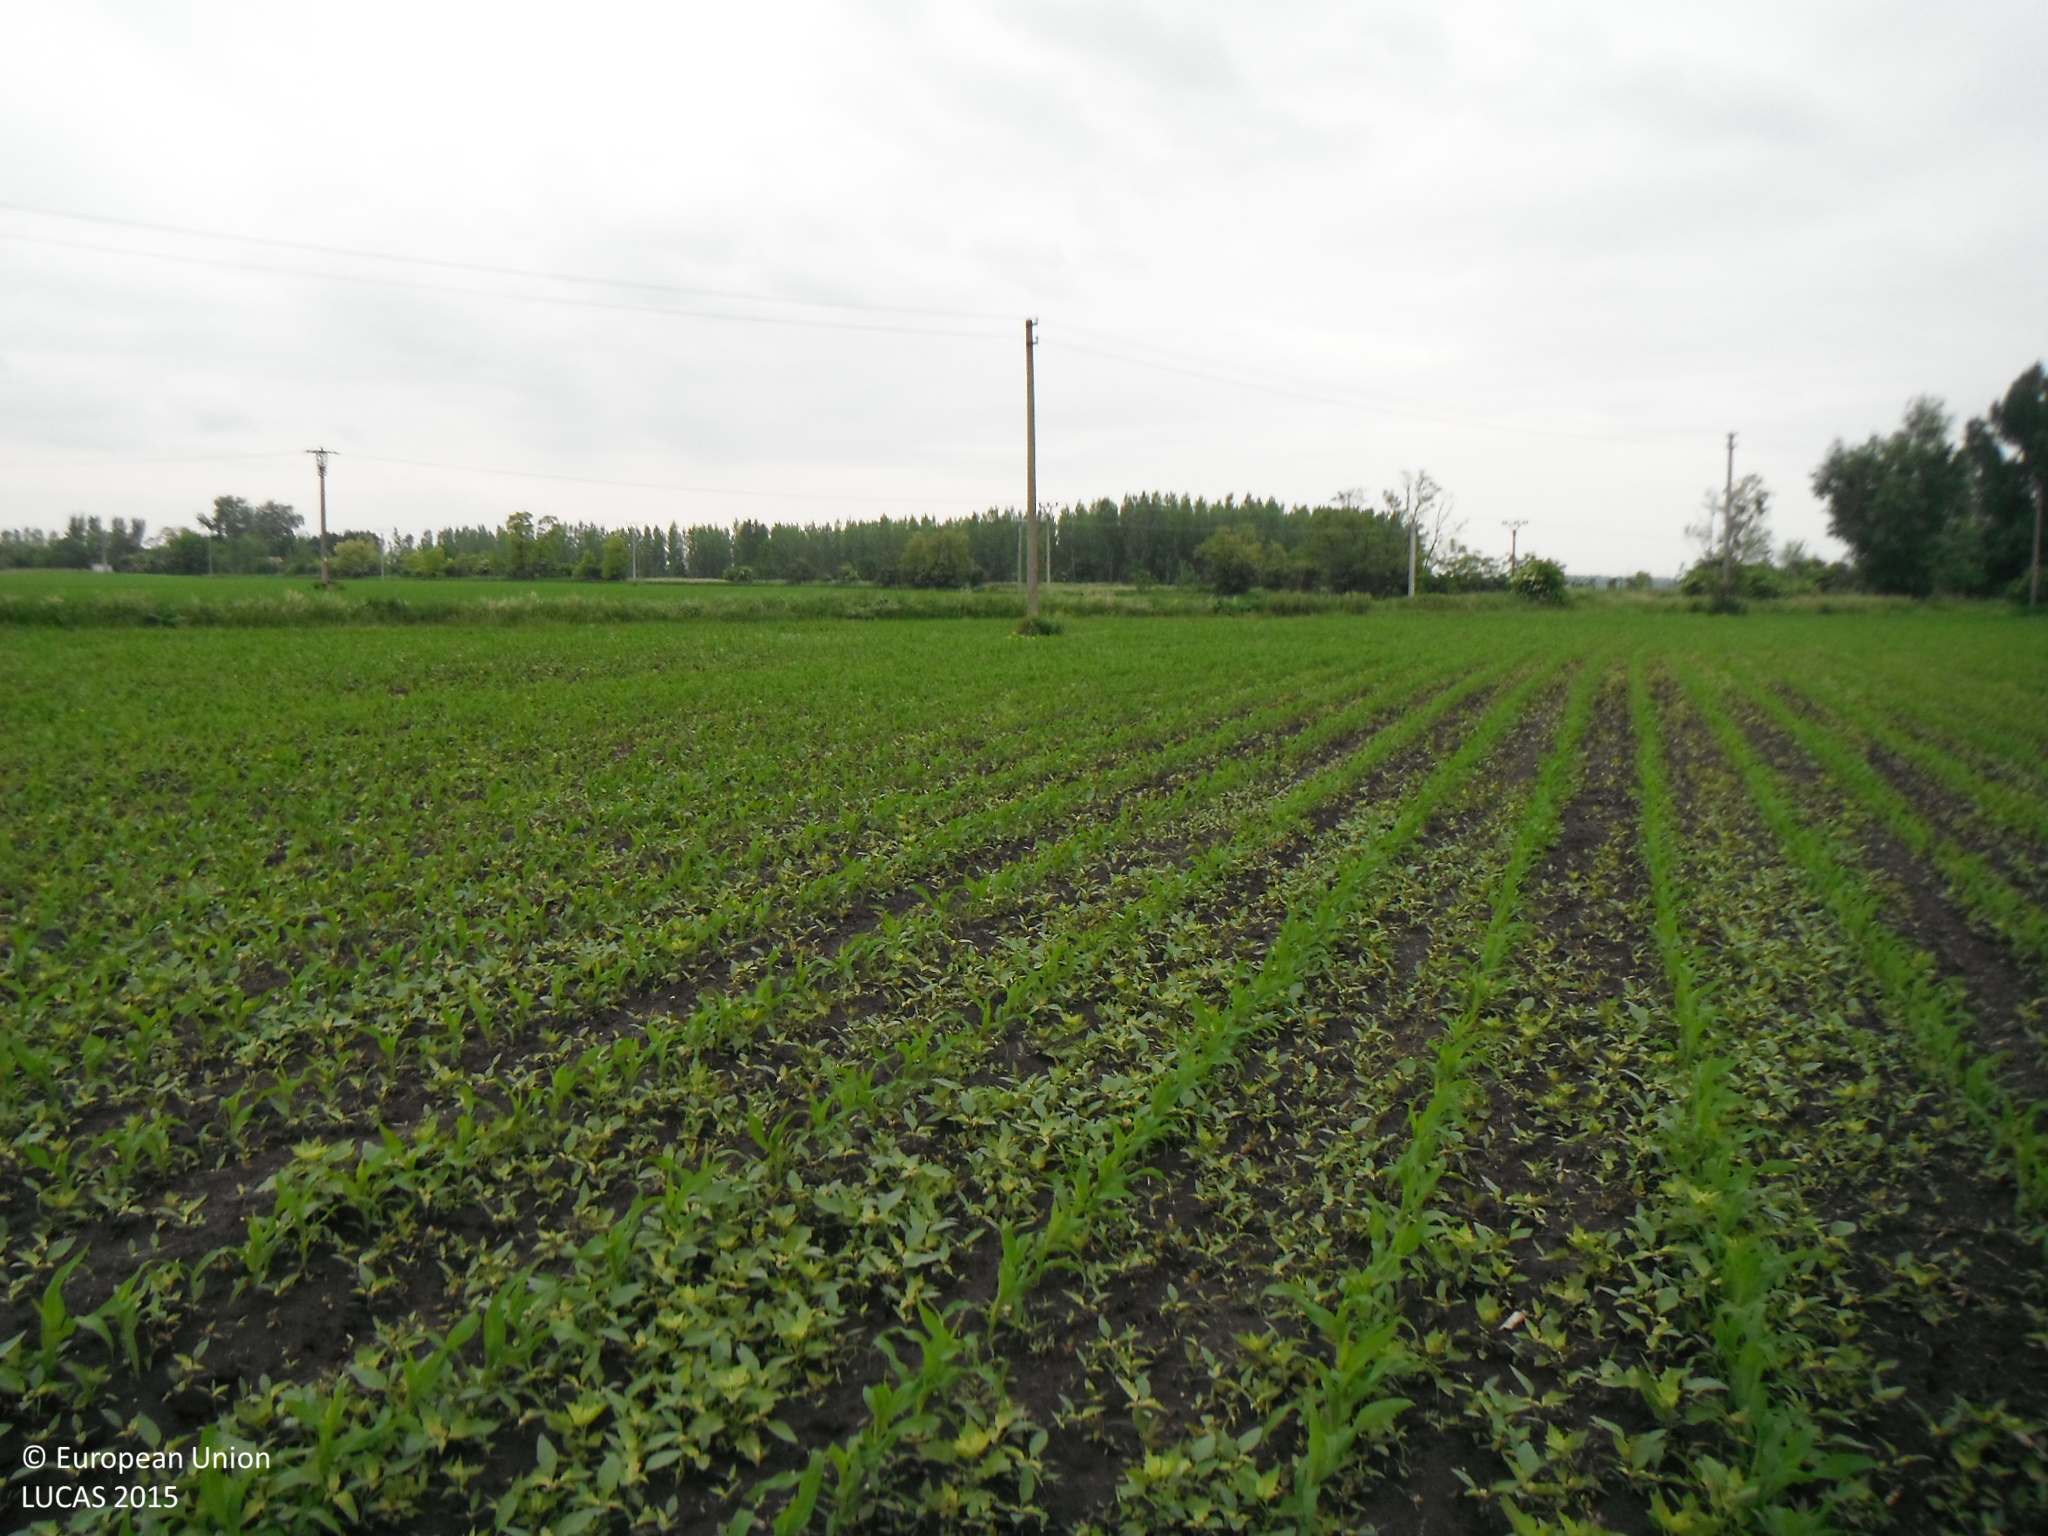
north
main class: Cropland
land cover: Maize
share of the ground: 25 - 50 %
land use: Agriculture (excluding fallow land and kitchen gardens)
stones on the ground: < 10 %
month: May
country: SK
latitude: 47.9298
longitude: 17.7872
